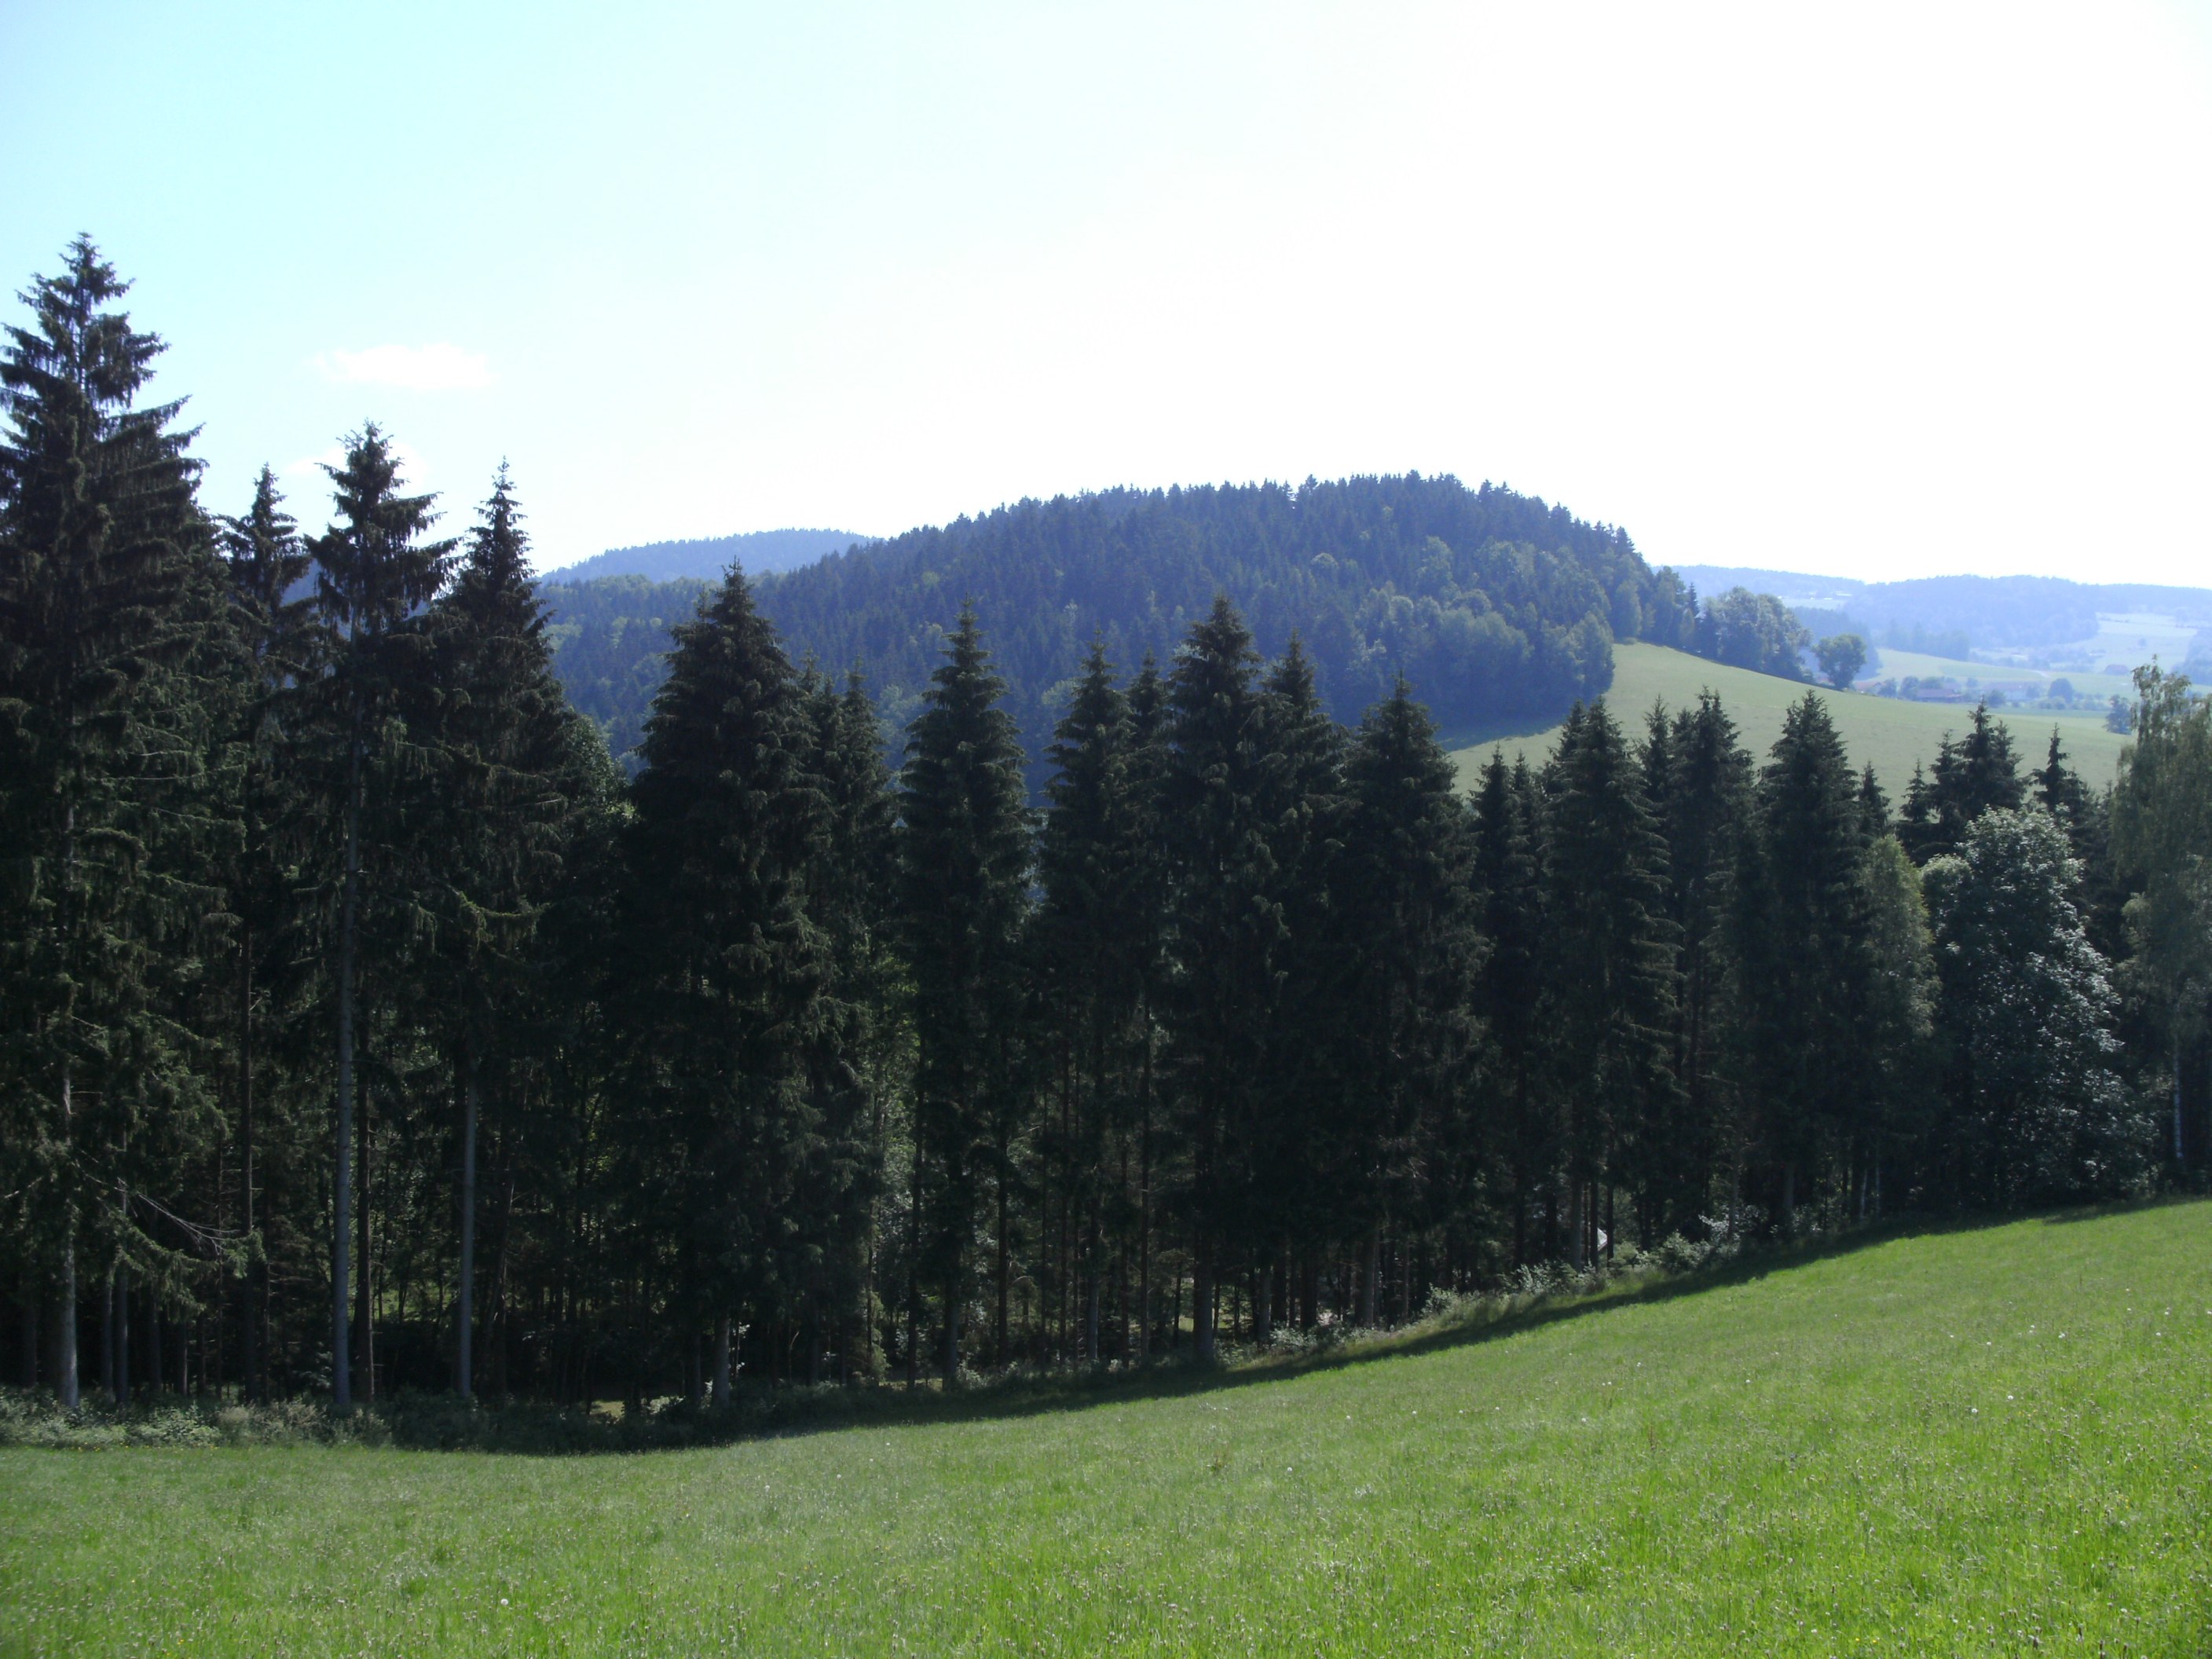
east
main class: Grassland
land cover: Grassland without tree/shrub cover
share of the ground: > 75 %
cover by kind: herbaceous plants 100 %
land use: Agriculture (excluding fallow land and kitchen gardens)
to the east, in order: Grassland without tree/shrub cover; Spruce dominated coniferous woodland; Tracks; Spruce dominated mixed woodland; Rivers and streams; Broadleaved woodland; Grassland without tree/shrub cover; Ditches and canals; Tracks; Ditches and canals; Spruce dominated coniferous woodland; Fences; Grassland without tree/shrub cover; Spruce dominated mixed woodland; Broadleaved woodland; Spruce dominated mixed woodland; Grassland without tree/shrub cover; Fences; Grassland without tree/shrub cover
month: June
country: AT
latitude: 48.4138
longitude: 14.2020
